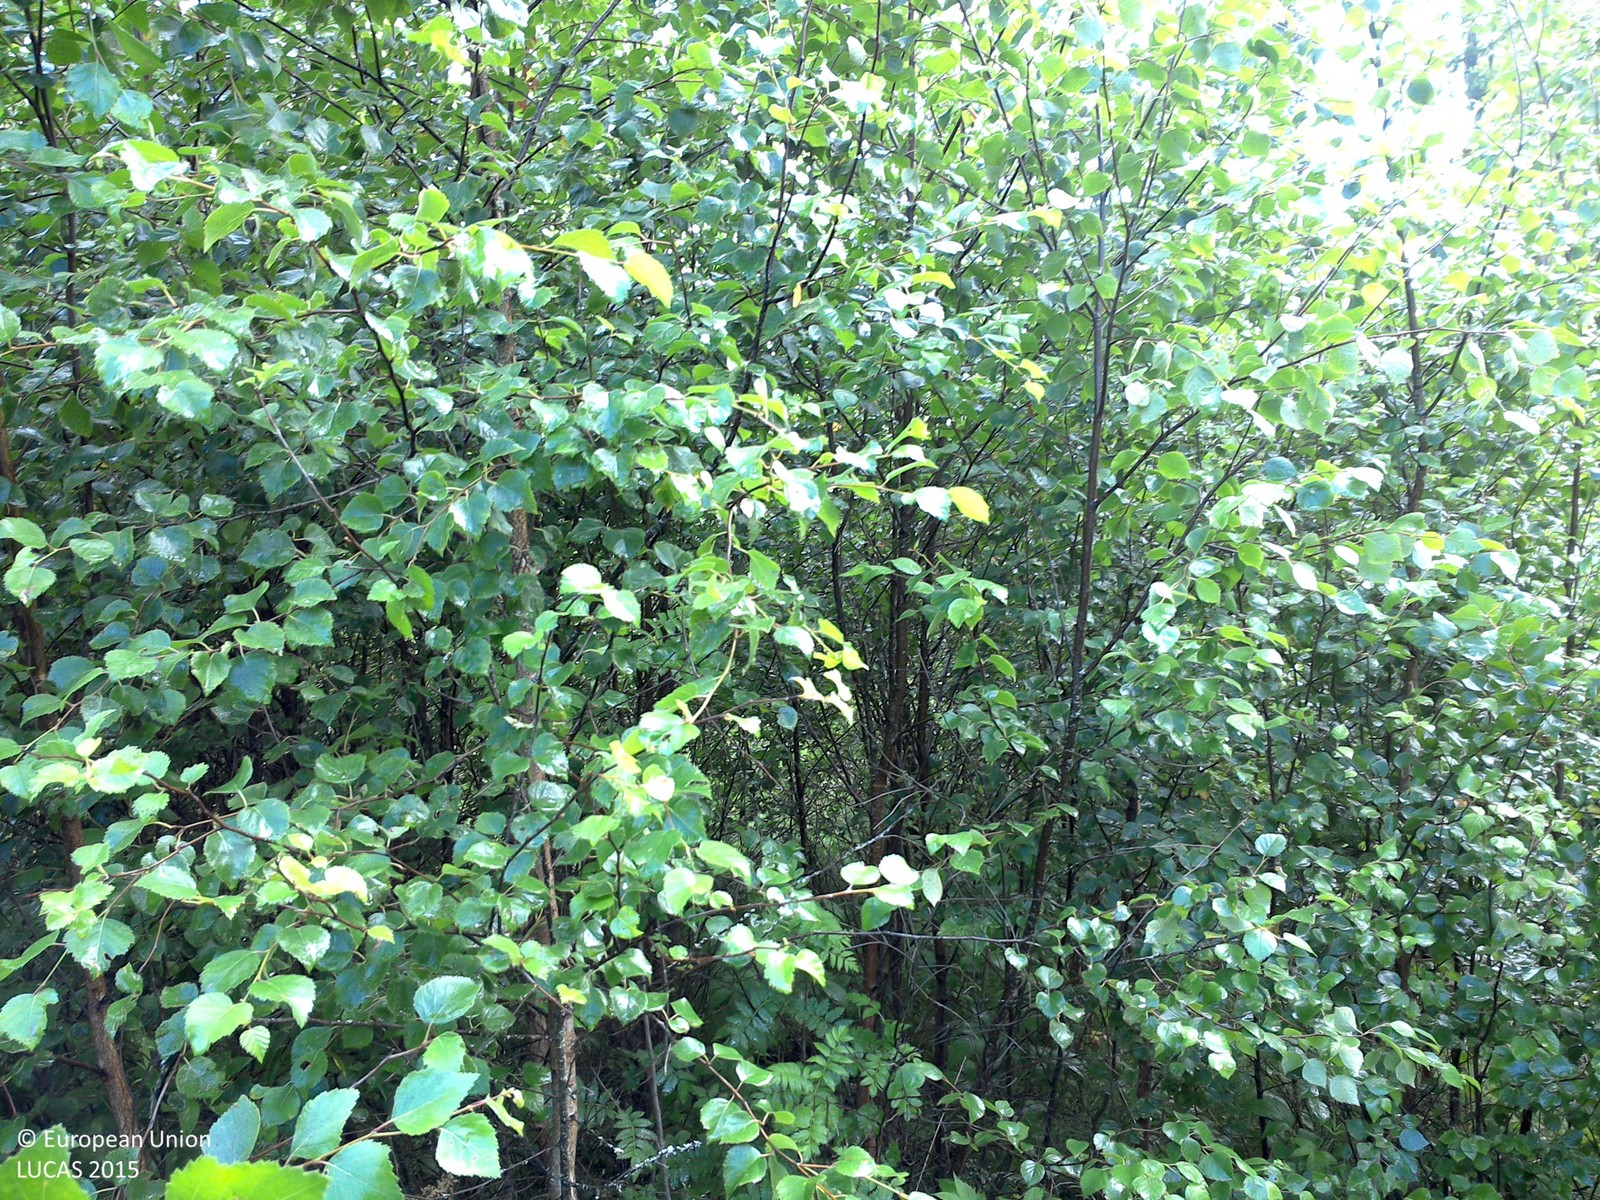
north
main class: Woodland
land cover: Broadleaved woodland
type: boreal forest
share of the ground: > 75 %
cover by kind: broadleaved forest trees 80 %, shrubs 10 %, herbaceous plants 10 %
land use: Forestry
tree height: < 5 m
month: July
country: SE
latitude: 57.9508
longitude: 14.8779
